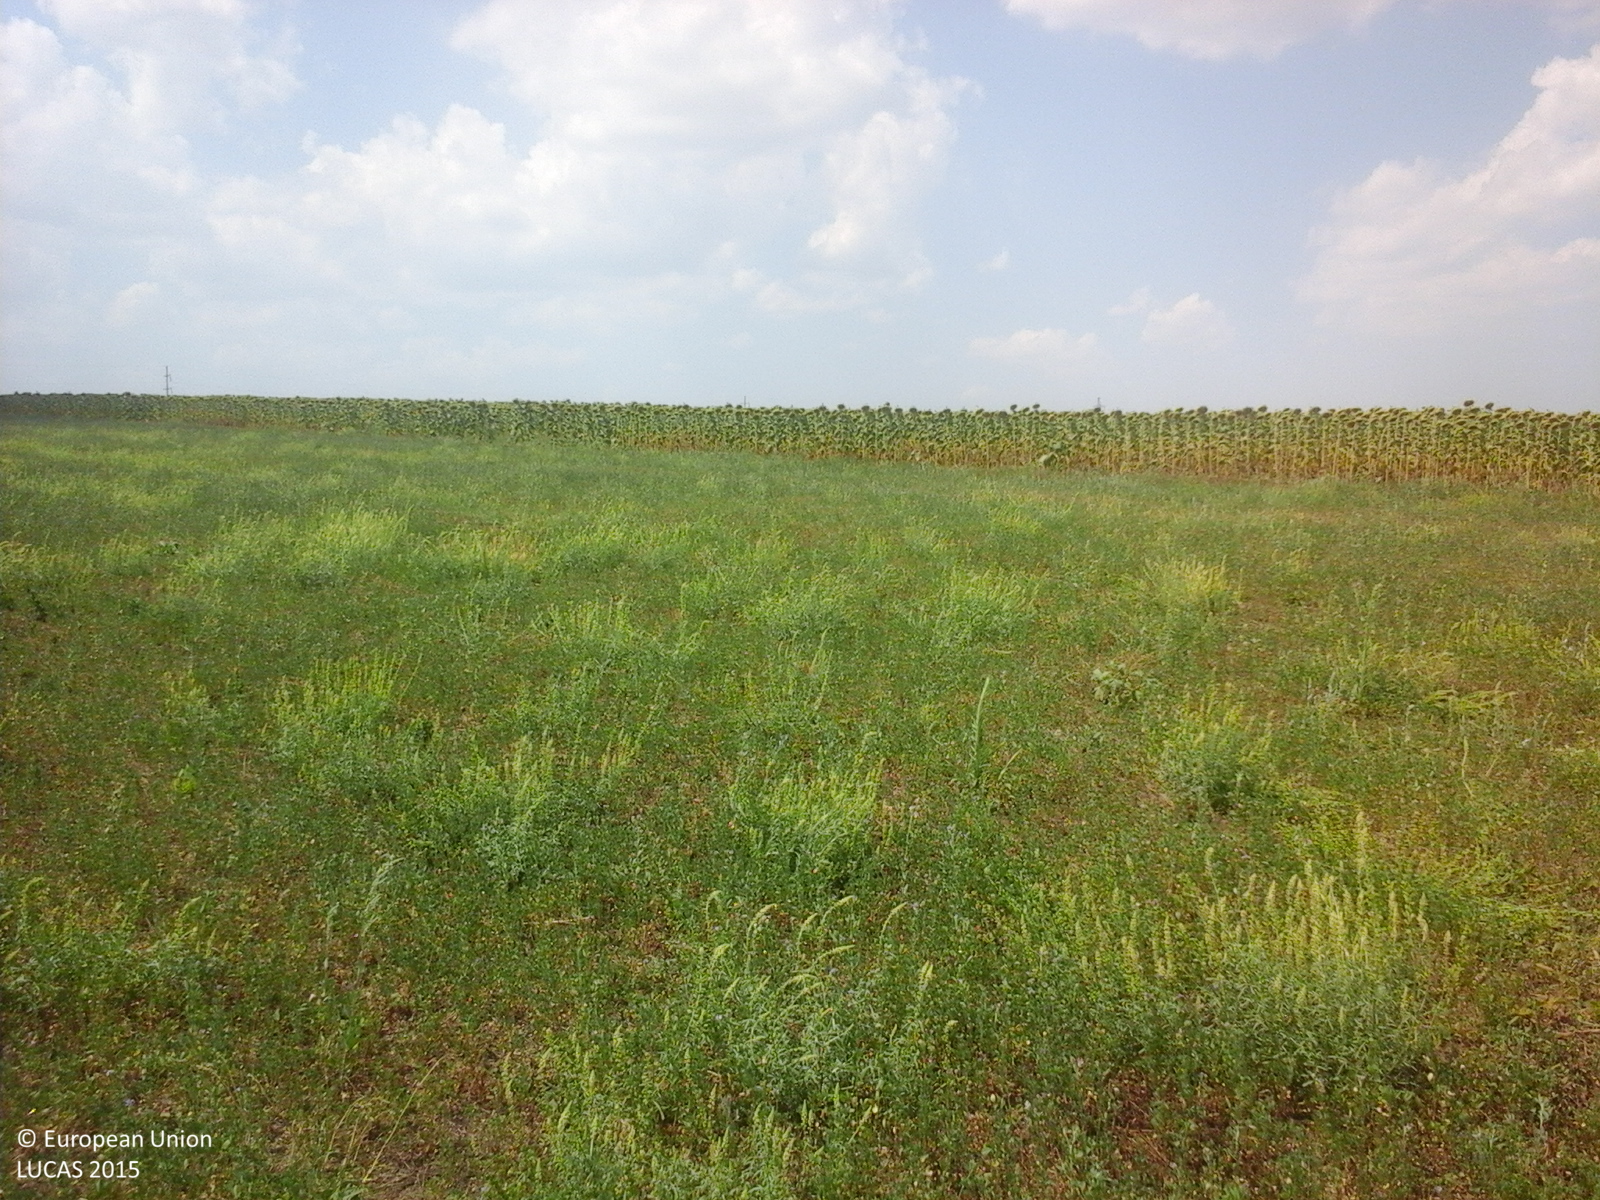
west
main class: Cropland
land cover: Lucerne
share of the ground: > 75 %
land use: Agriculture (excluding fallow land and kitchen gardens)
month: July
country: RO
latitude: 46.2399
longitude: 28.0350
